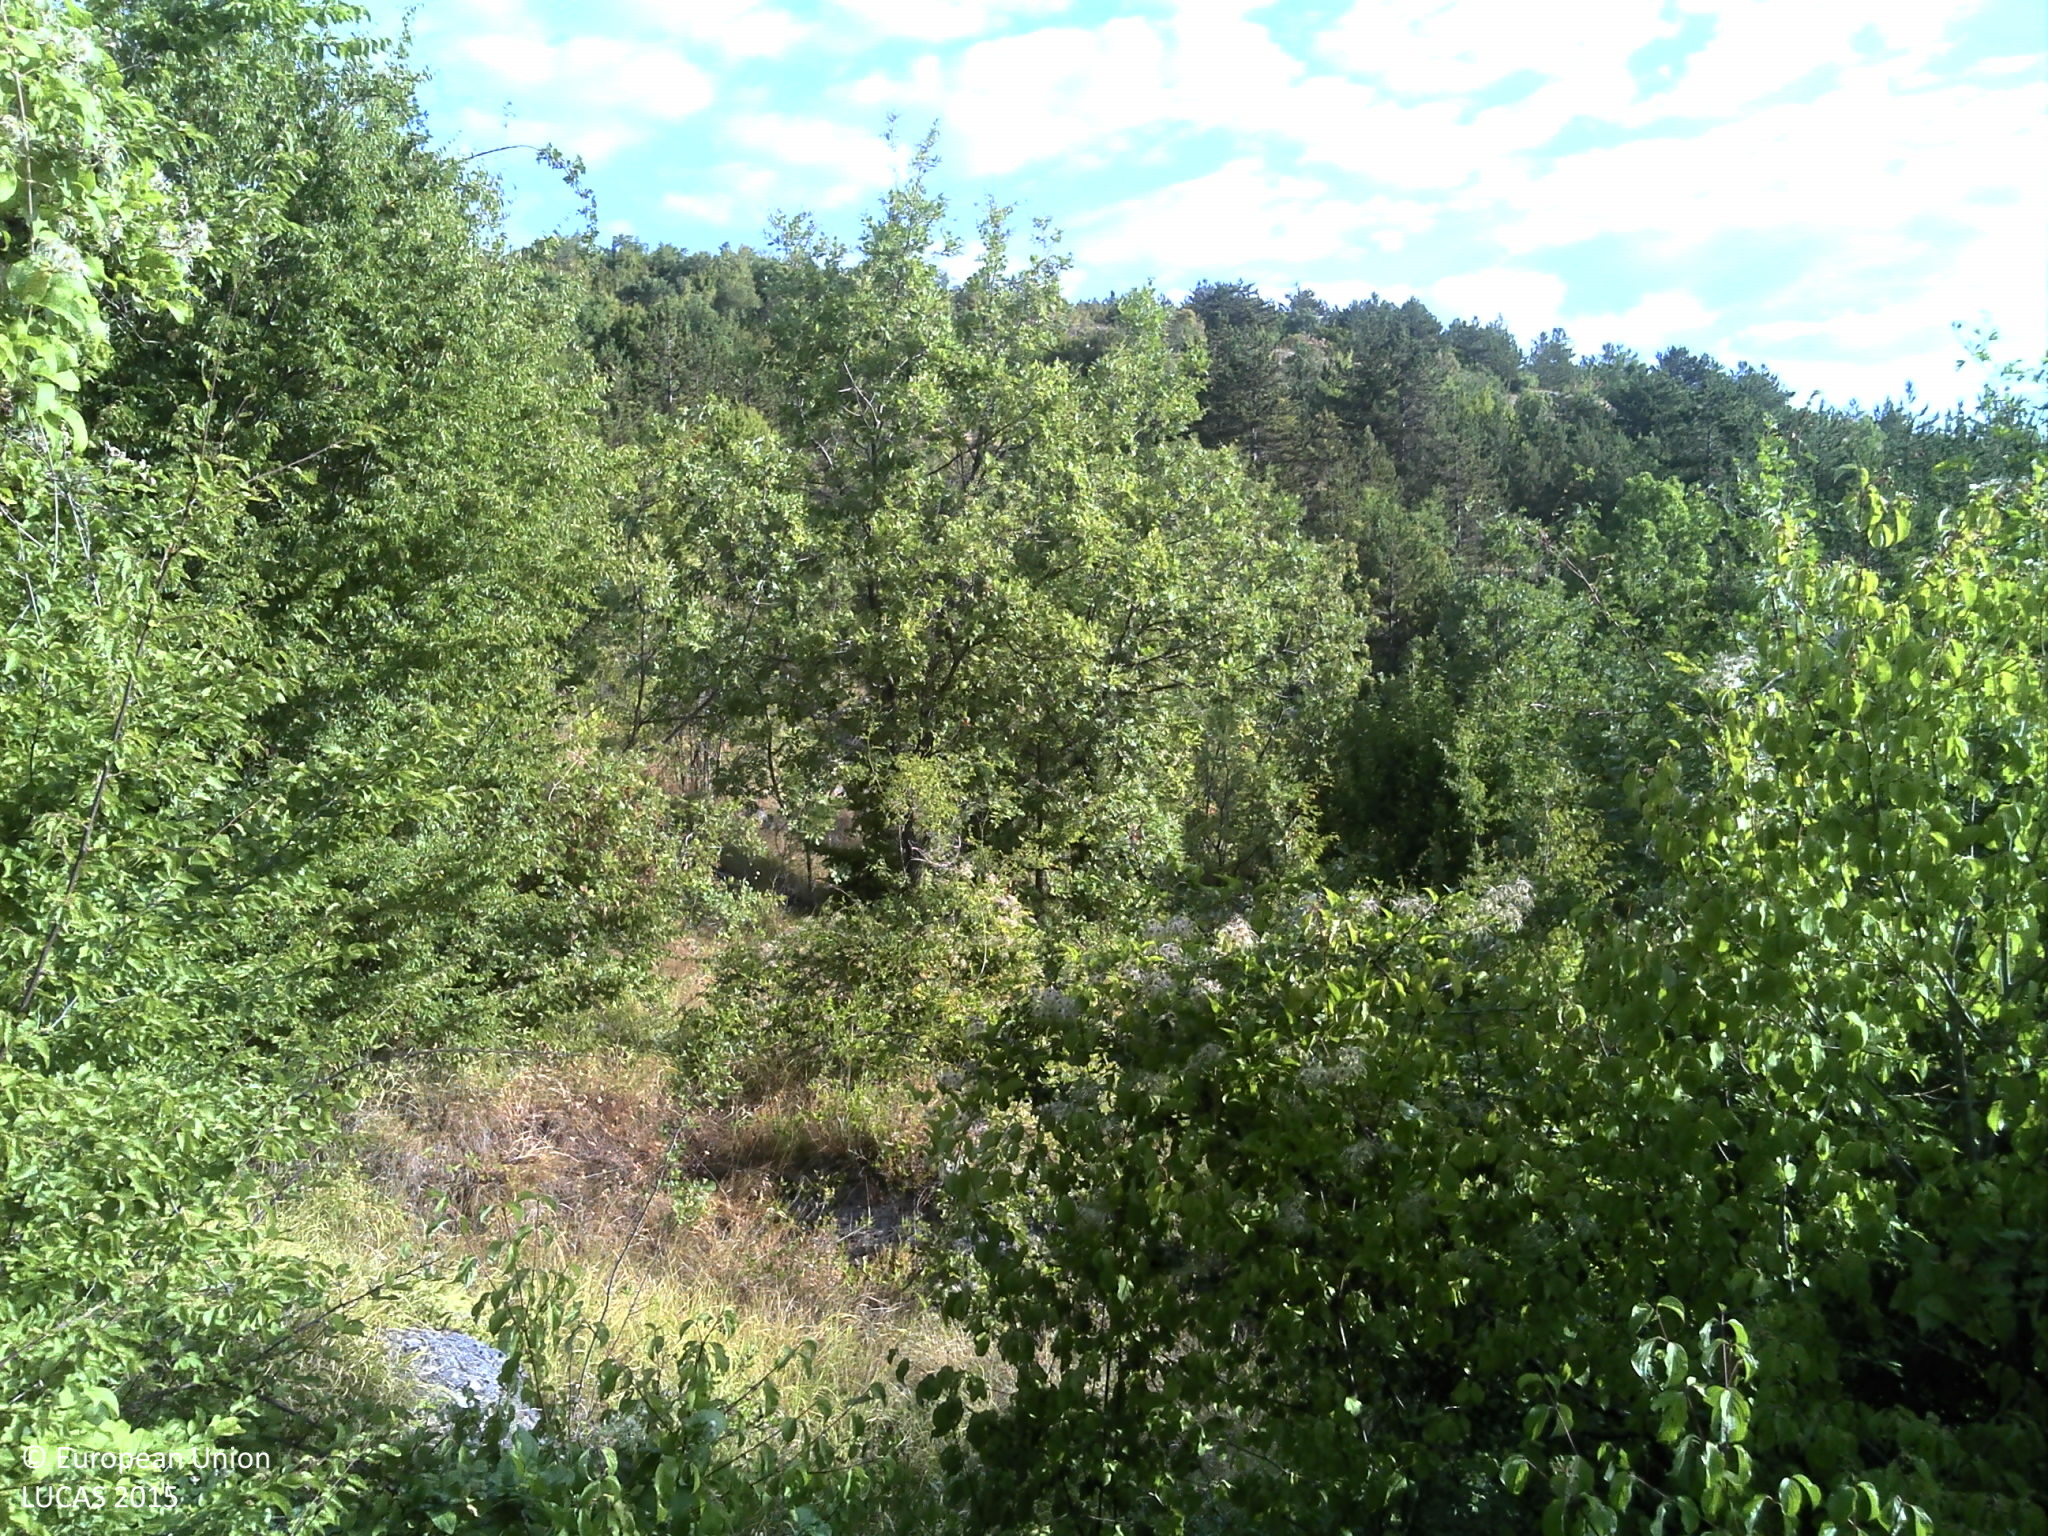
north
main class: Shrubland
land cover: Shrubland with sparse tree cover
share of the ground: > 75 %
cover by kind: shrubs 65 %, herbaceous plants 20 %, broadleaved forest trees 5 %, lichens and mosses 5 %, consolidated bare surface 5 %
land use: Semi-natural and natural areas not in use
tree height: < 5 m
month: July
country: HR
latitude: 43.4556
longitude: 17.0978
